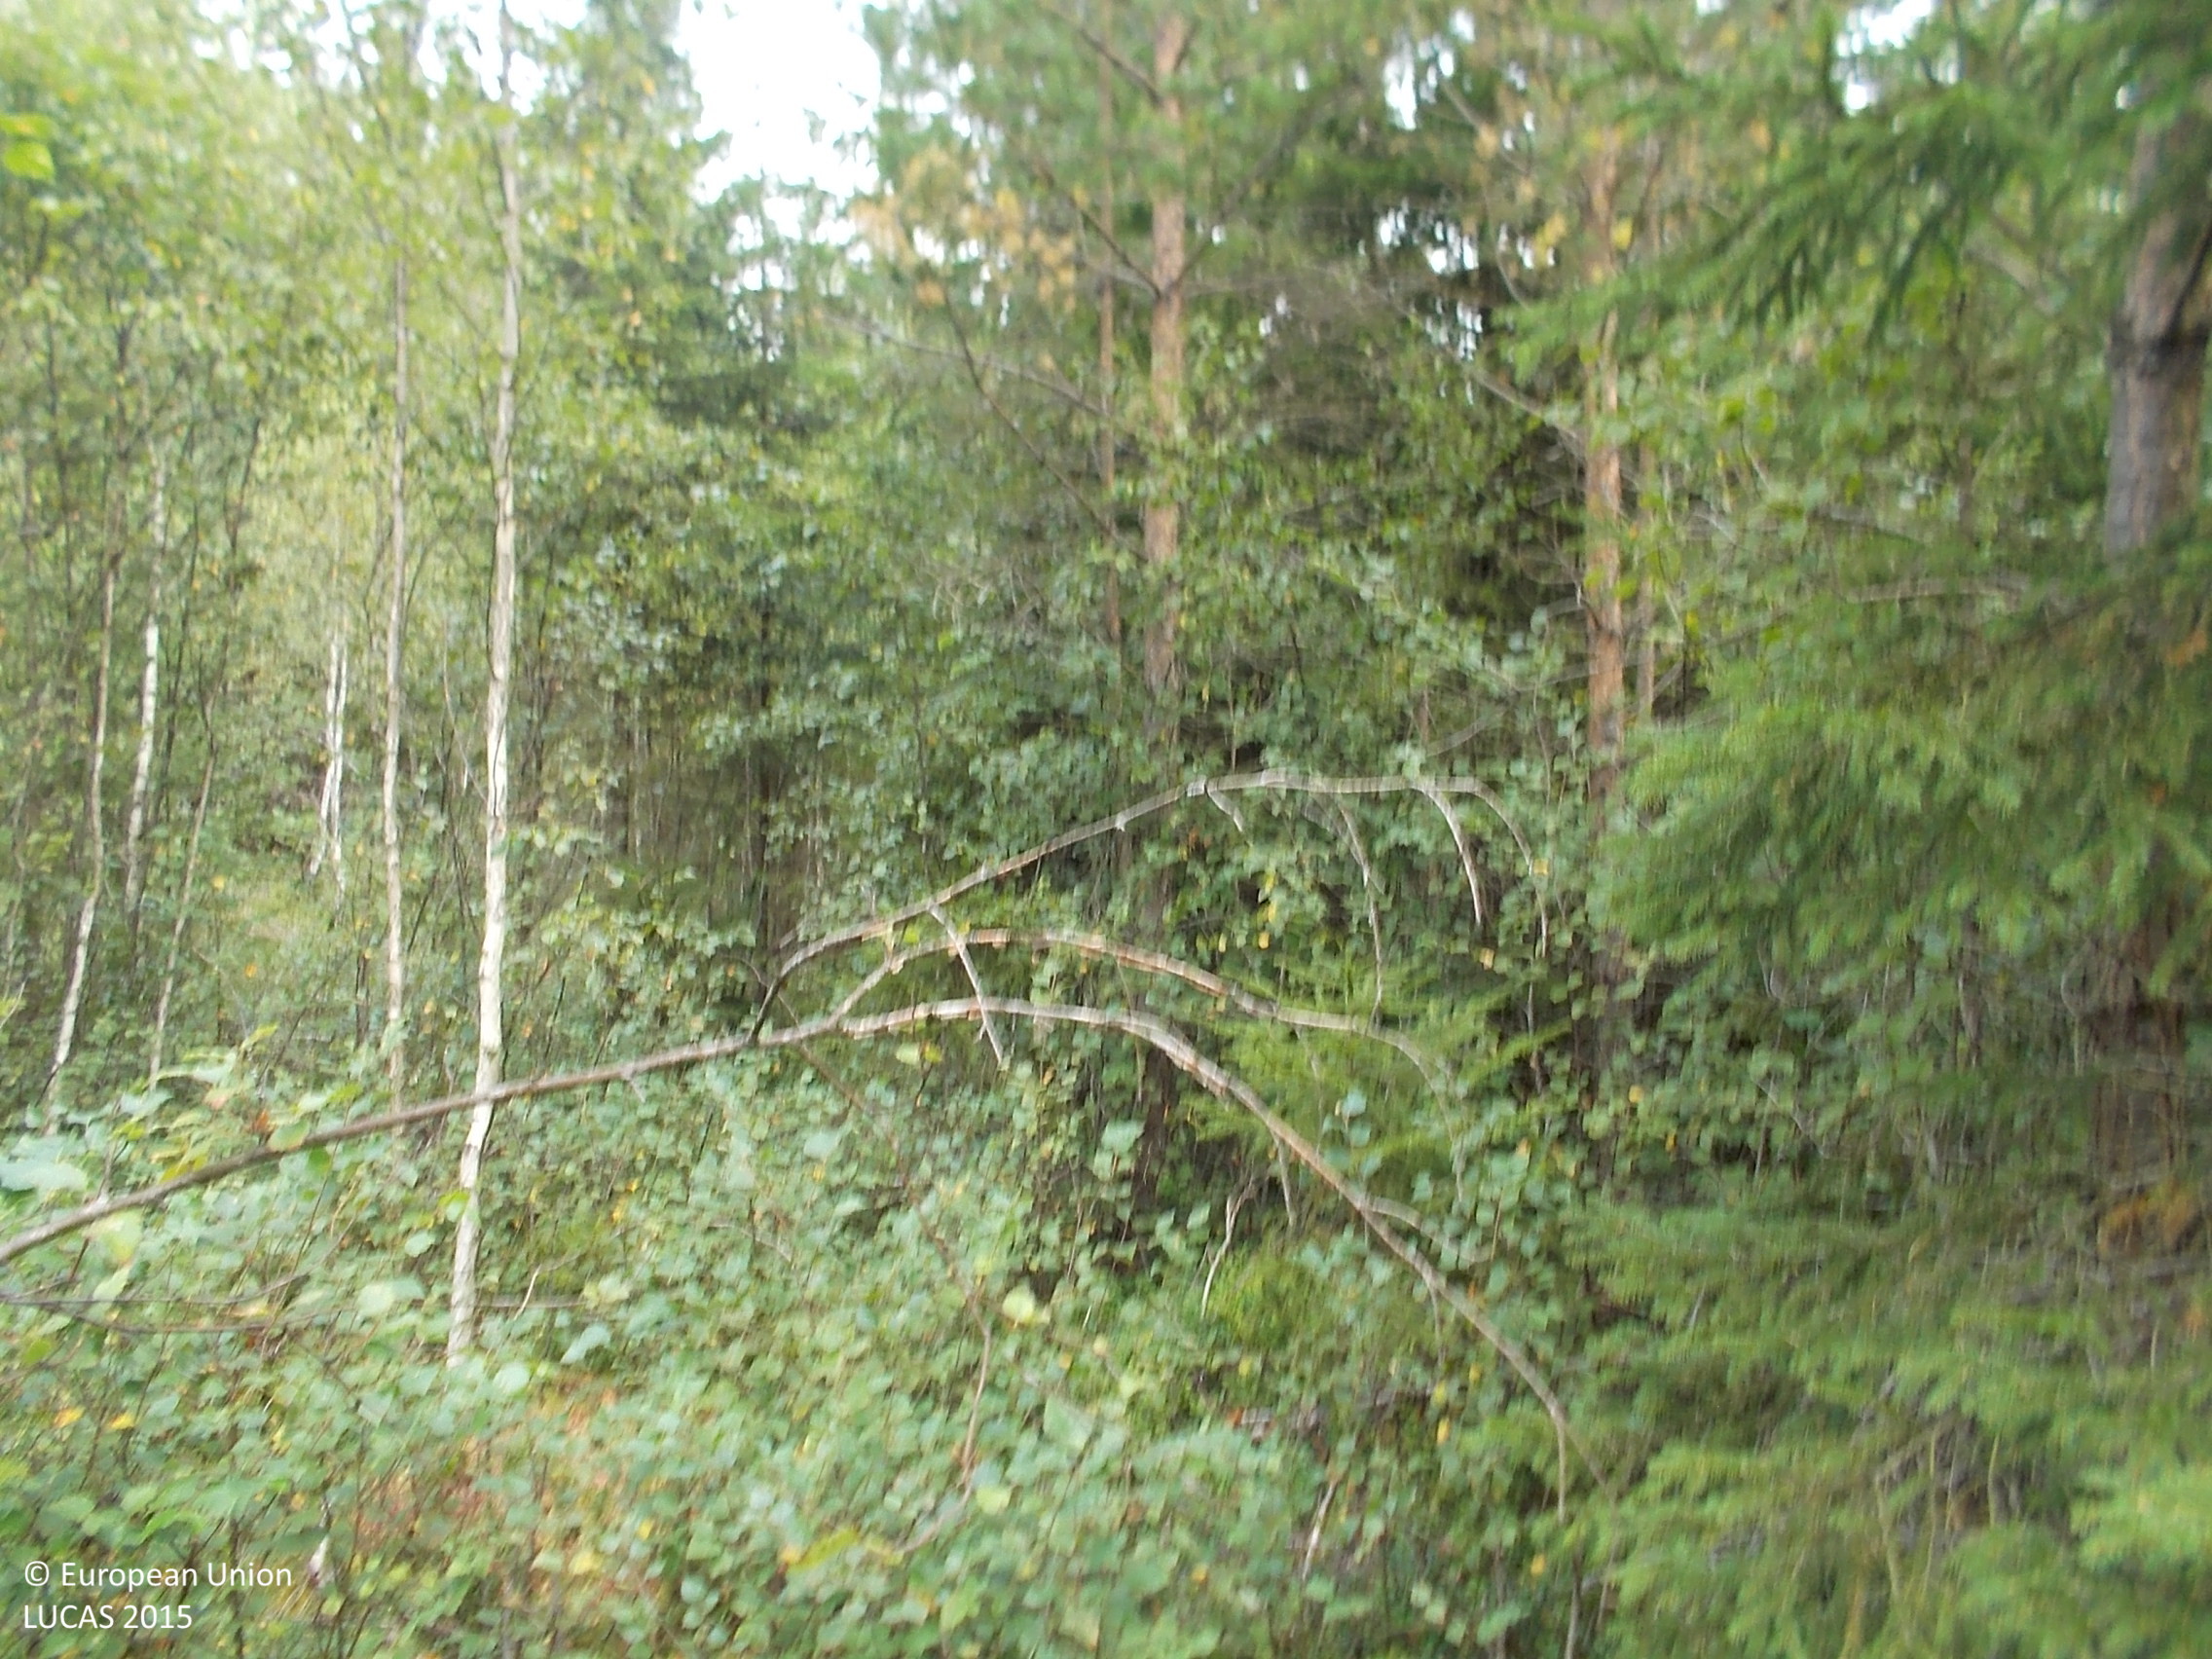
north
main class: Woodland
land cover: Spruce dominated mixed woodland
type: boreal forest
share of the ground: > 75 %
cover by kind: broadleaved forest trees 45 %, coniferous forest trees 40 %, shrubs 5 %, herbaceous plants 5 %, lichens and mosses 5 %
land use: Forestry
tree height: > 5 m
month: August
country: SE
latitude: 57.3893
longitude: 13.2068
